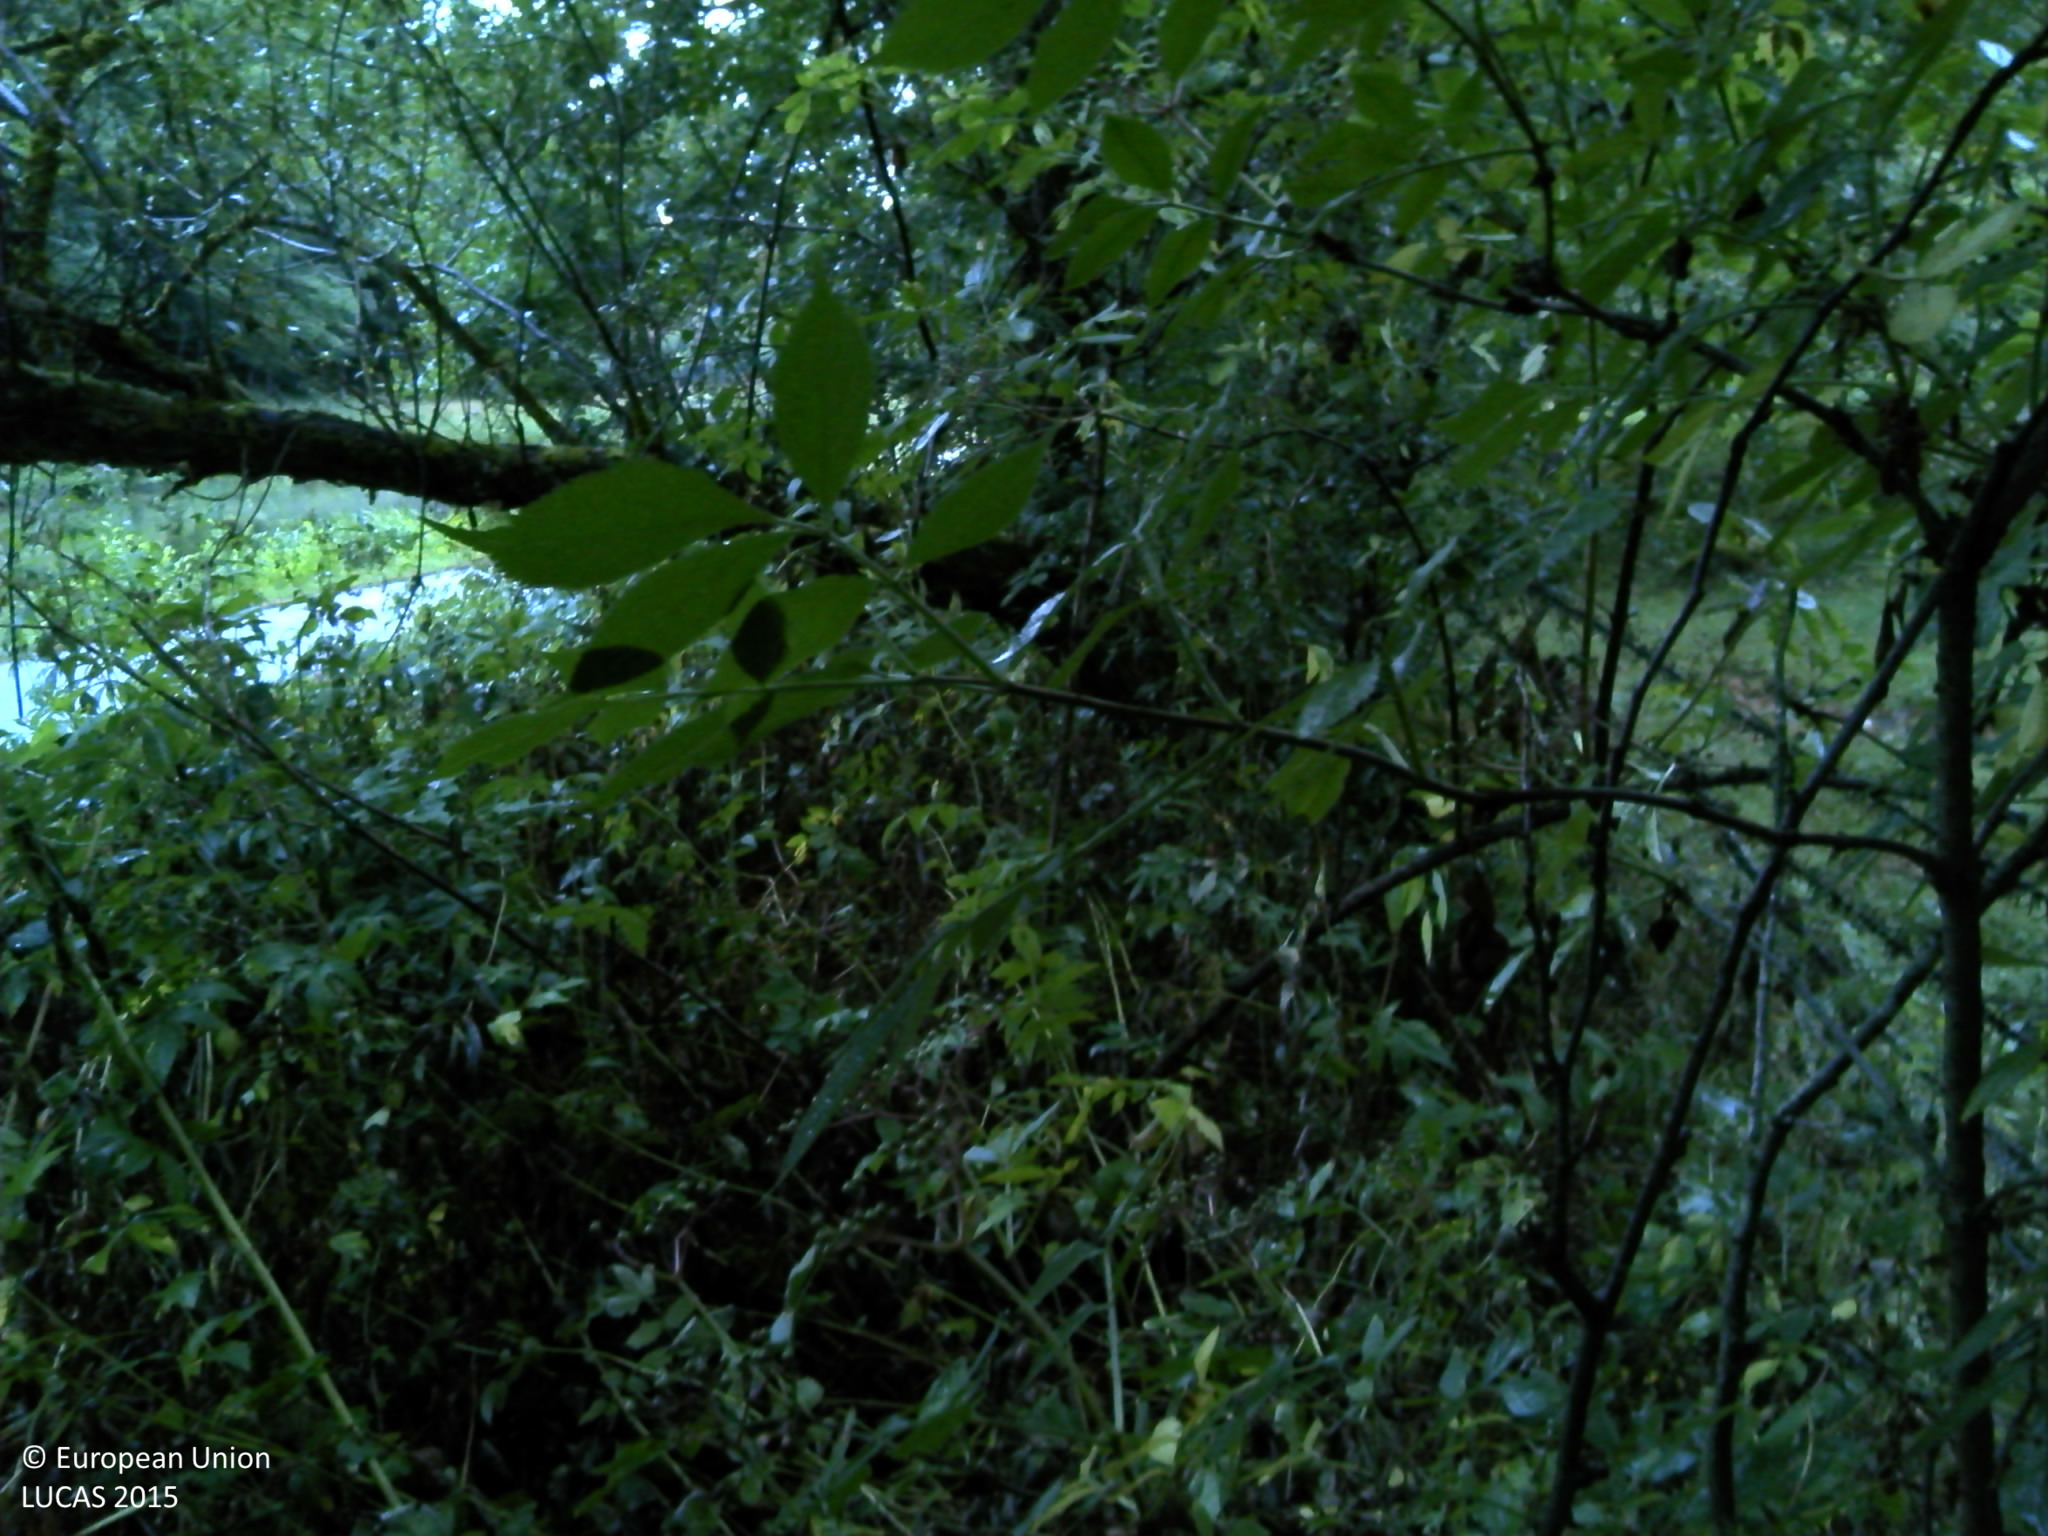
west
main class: Grassland
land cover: Grassland with sparse tree/shrub cover
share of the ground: > 75 %
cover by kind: herbaceous plants 95 %, broadleaved forest trees 5 %
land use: Agriculture (excluding fallow land and kitchen gardens)
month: July
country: FR
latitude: 47.9783
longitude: 6.2095
